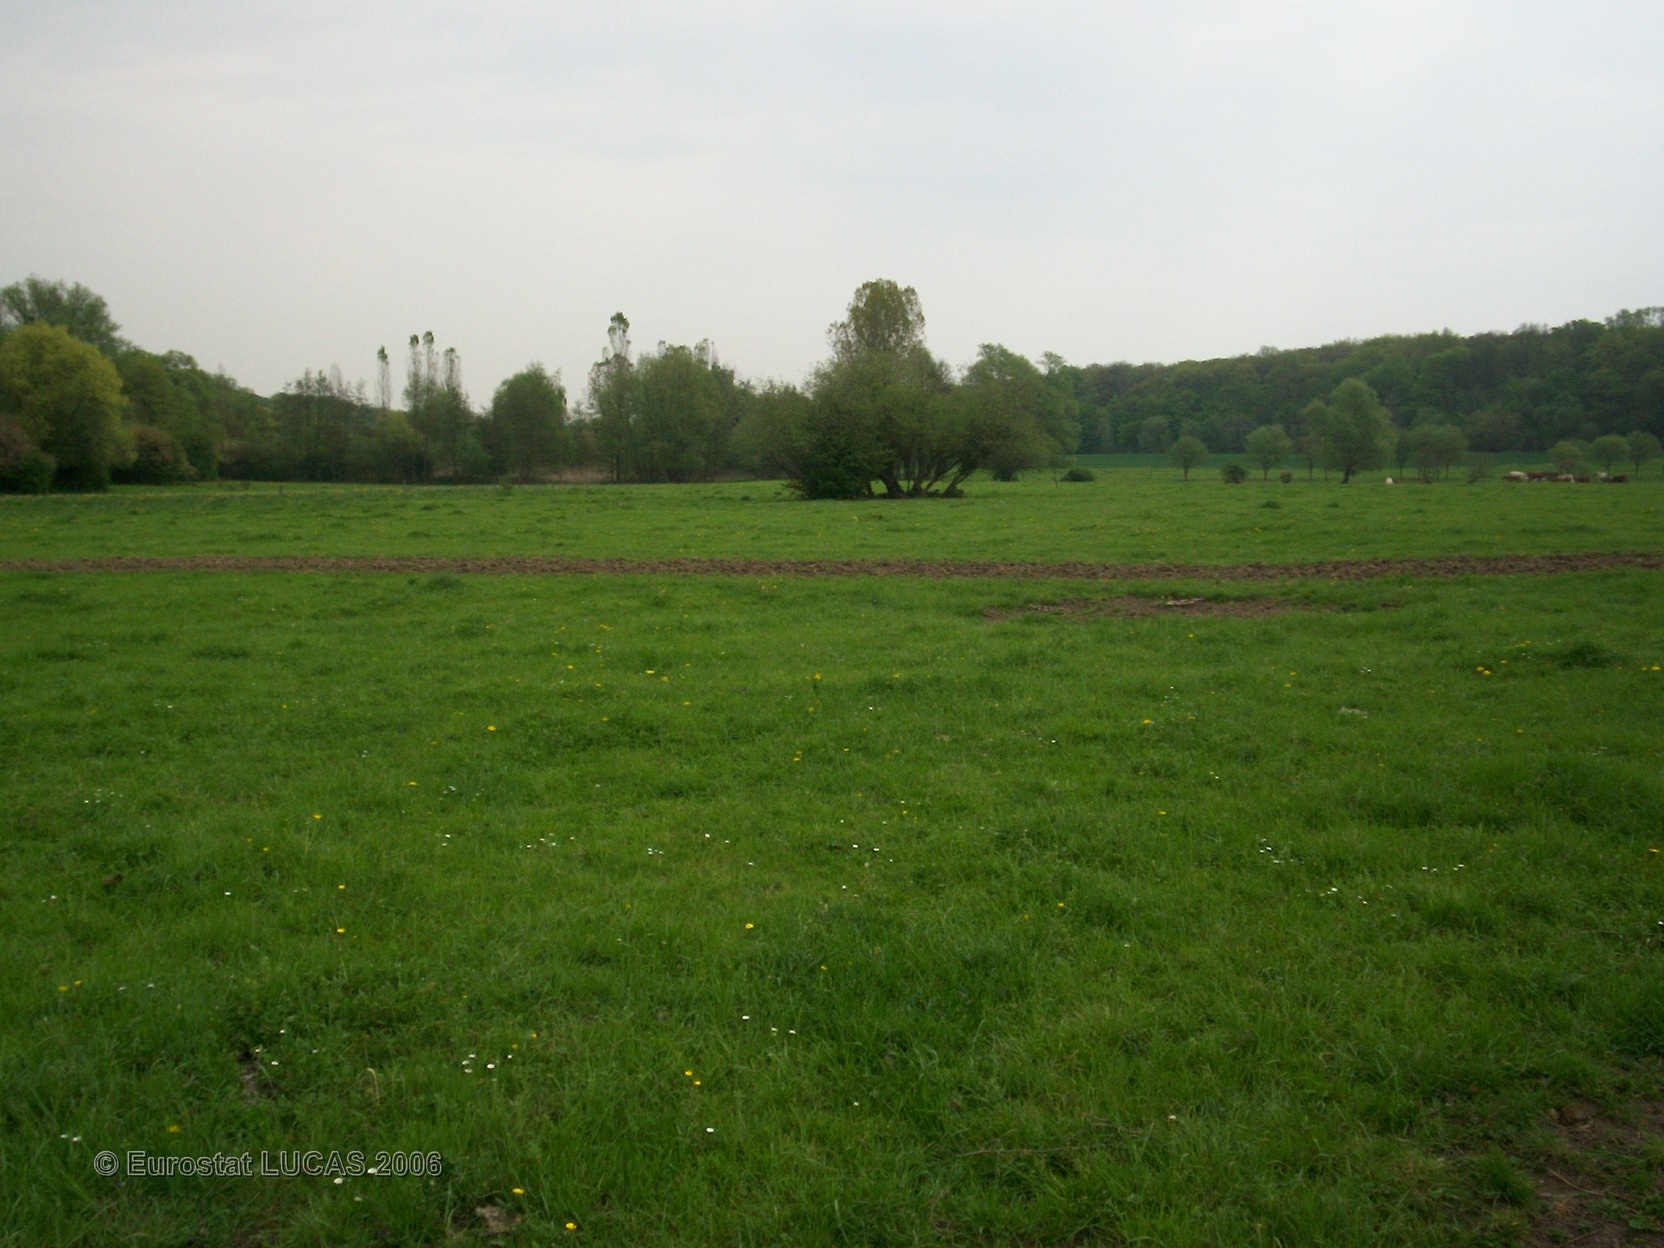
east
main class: Grassland
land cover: Grassland without tree/shrub cover
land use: Agriculture (excluding fallow land and kitchen gardens)
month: May
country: FR
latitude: 49.2287
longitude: 6.4433
